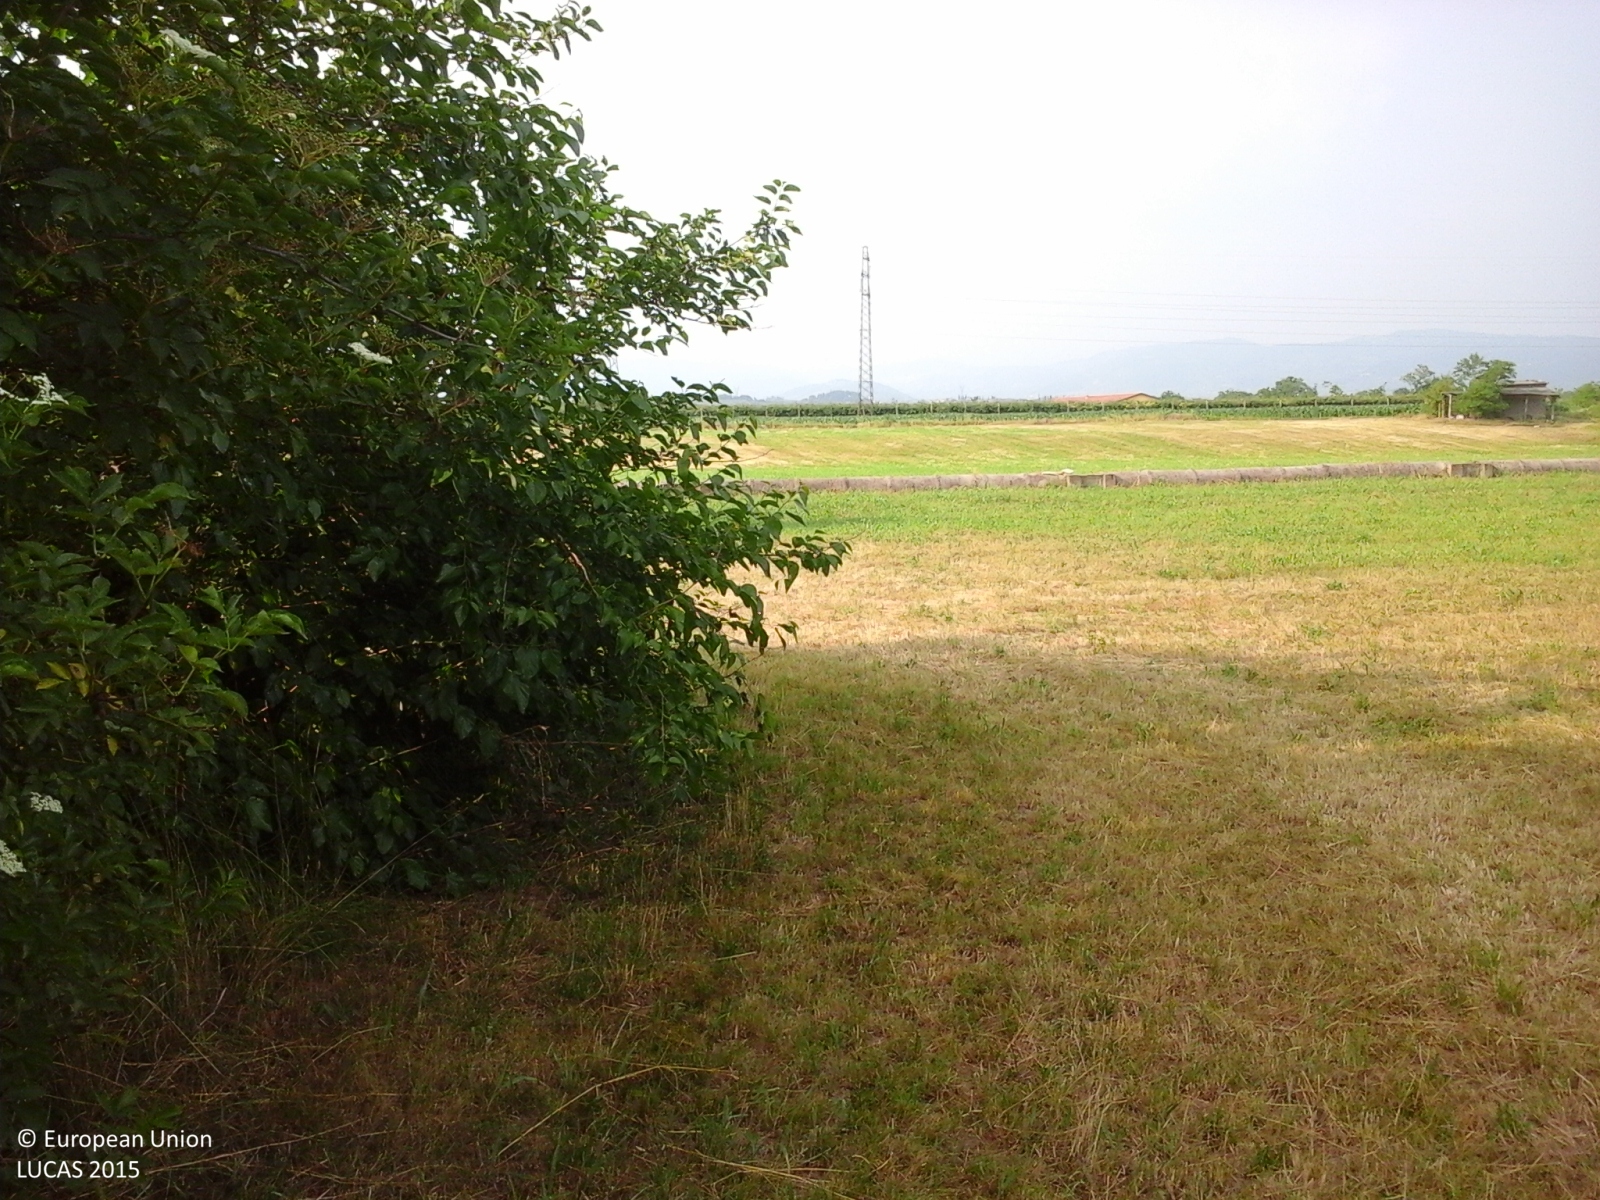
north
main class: Grassland
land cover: Spontaneously vegetated surfaces
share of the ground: > 75 %
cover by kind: herbaceous plants 100 %
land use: Agriculture (excluding fallow land and kitchen gardens)
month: June
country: IT
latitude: 45.4647
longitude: 10.8810
